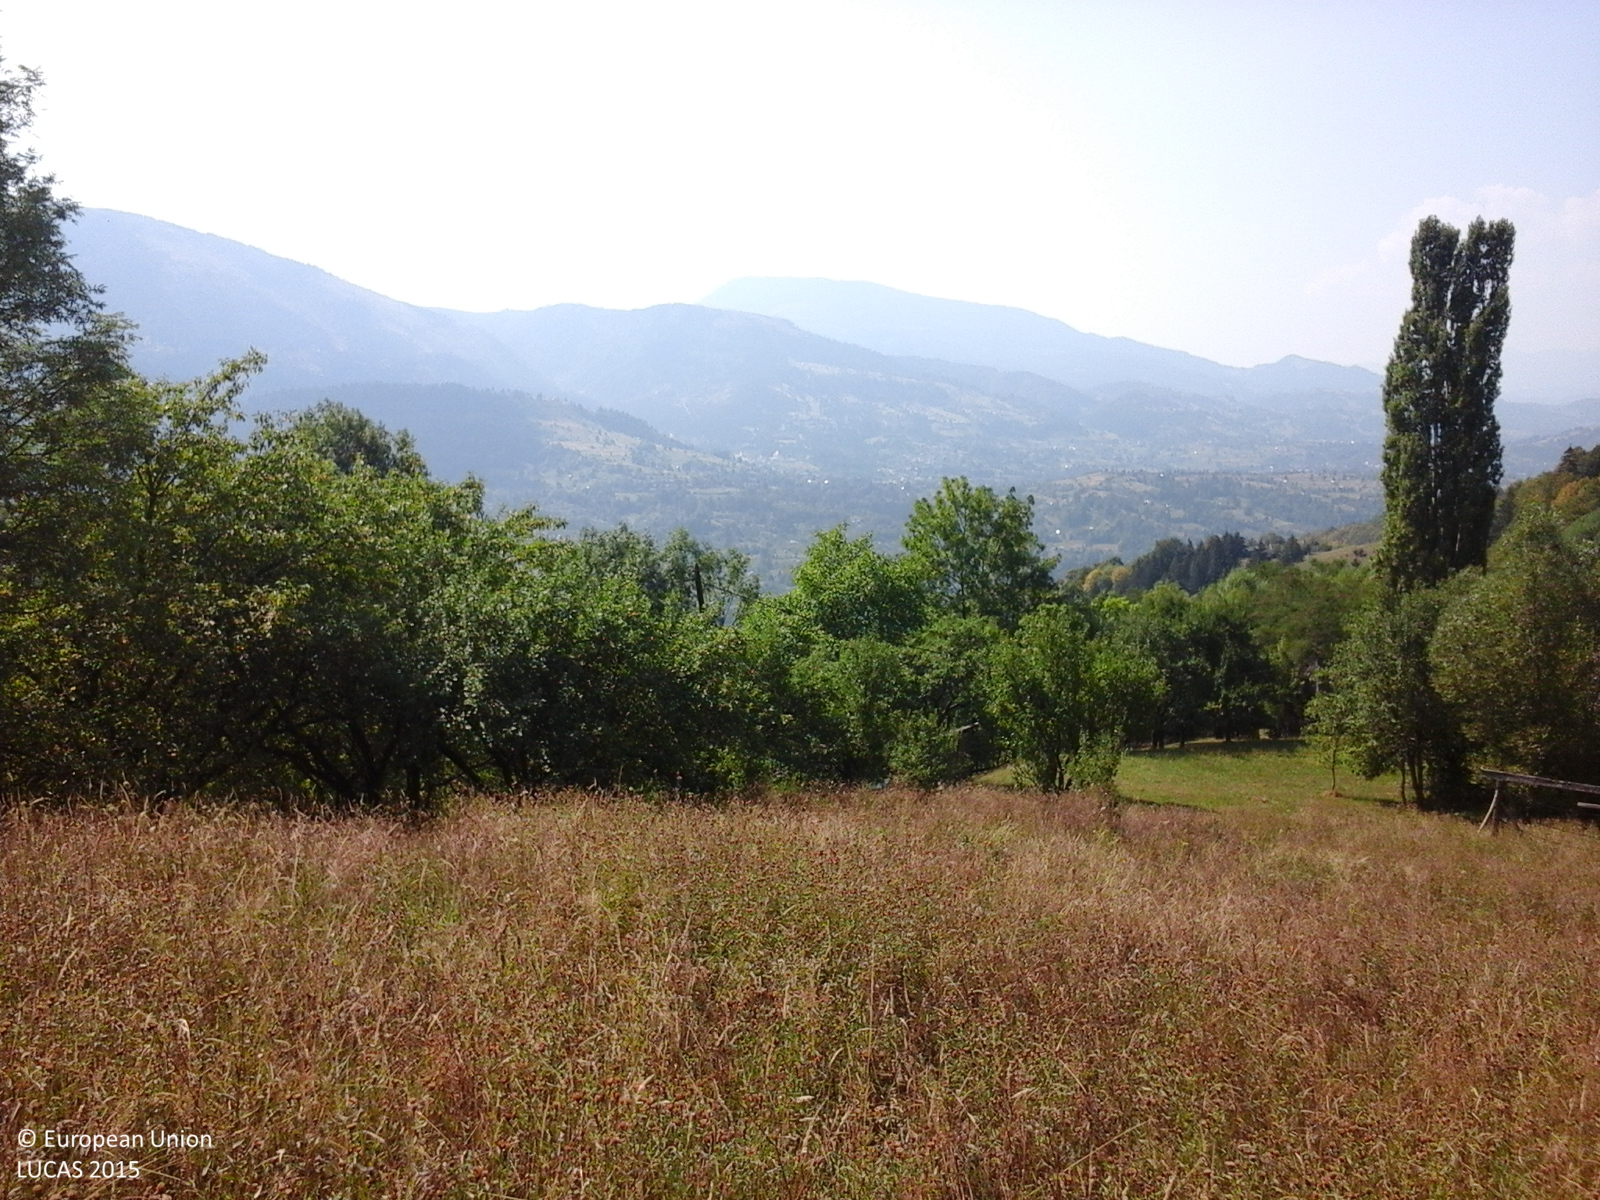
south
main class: Grassland
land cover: Grassland without tree/shrub cover
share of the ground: > 75 %
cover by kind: herbaceous plants 100 %
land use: Agriculture (excluding fallow land and kitchen gardens)
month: September
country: RO
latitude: 47.6691
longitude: 24.5726
